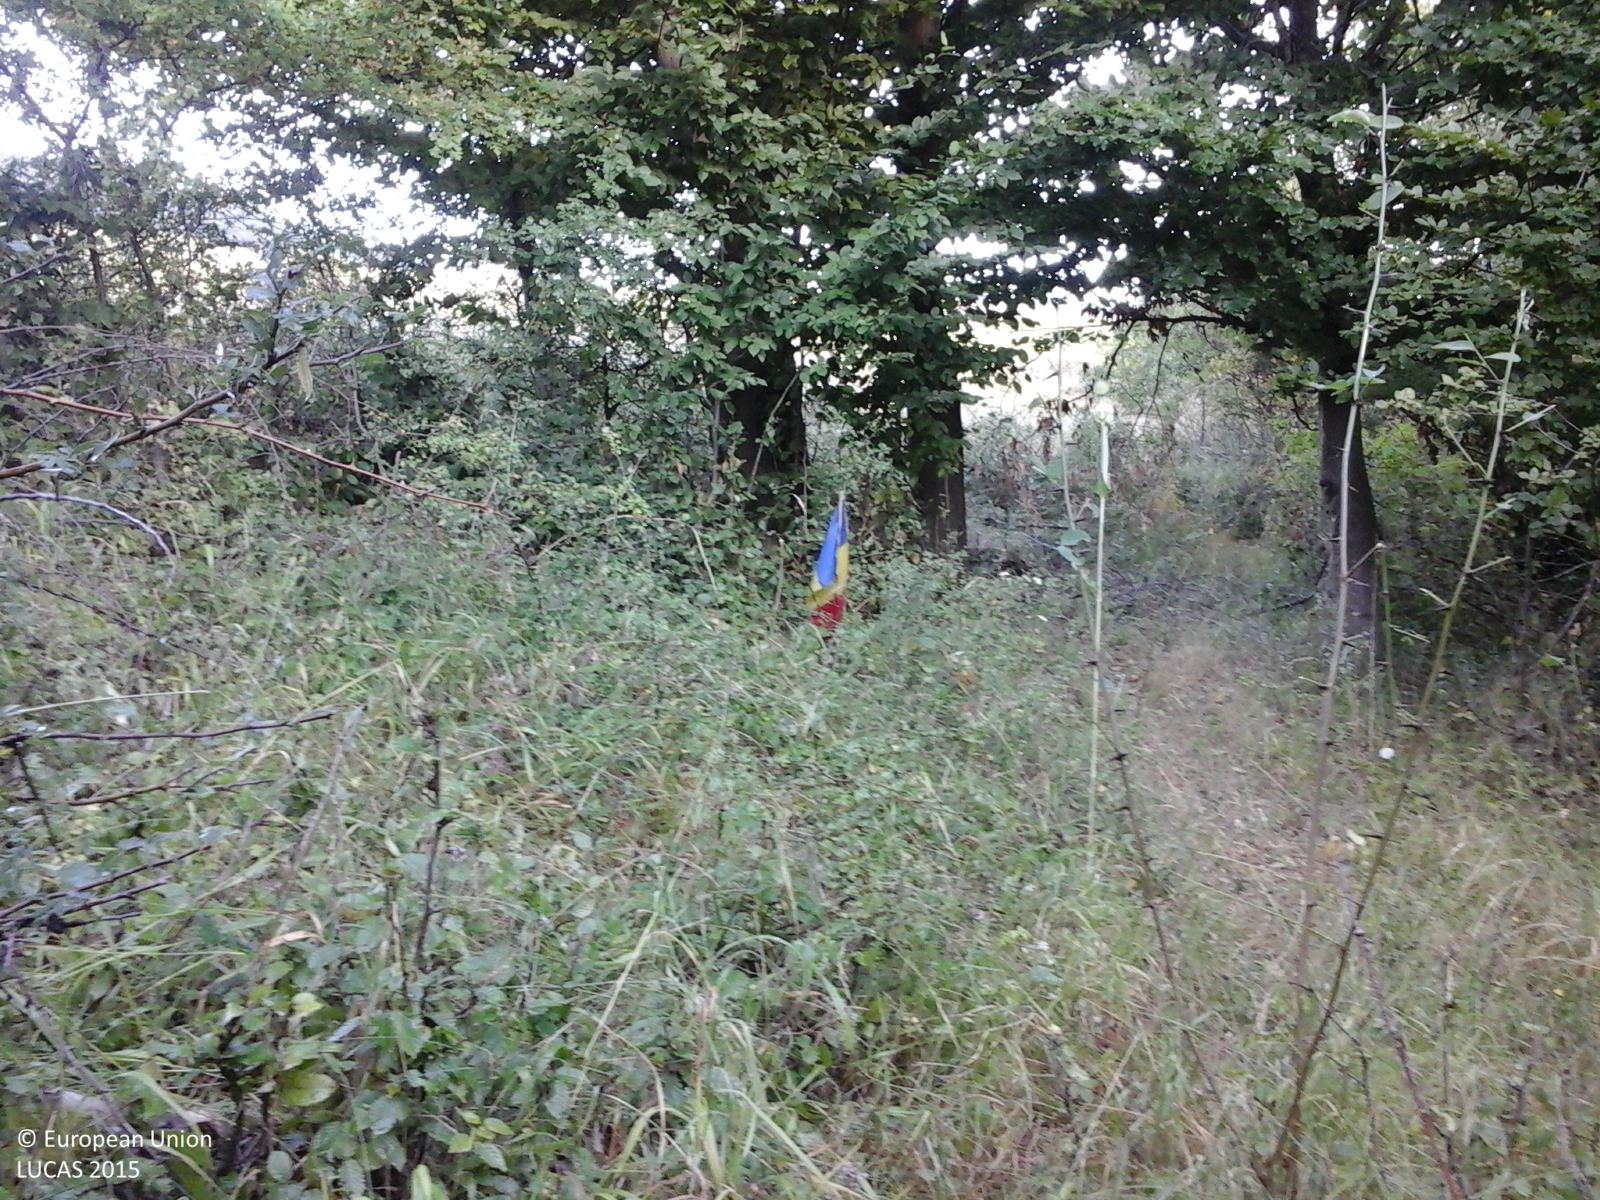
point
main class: Woodland
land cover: Broadleaved woodland
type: mesophytic deciduous forest
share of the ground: > 75 %
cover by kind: broadleaved forest trees 100 %
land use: Forestry
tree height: > 5 m
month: July
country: RO
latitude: 46.5503
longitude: 27.2812
